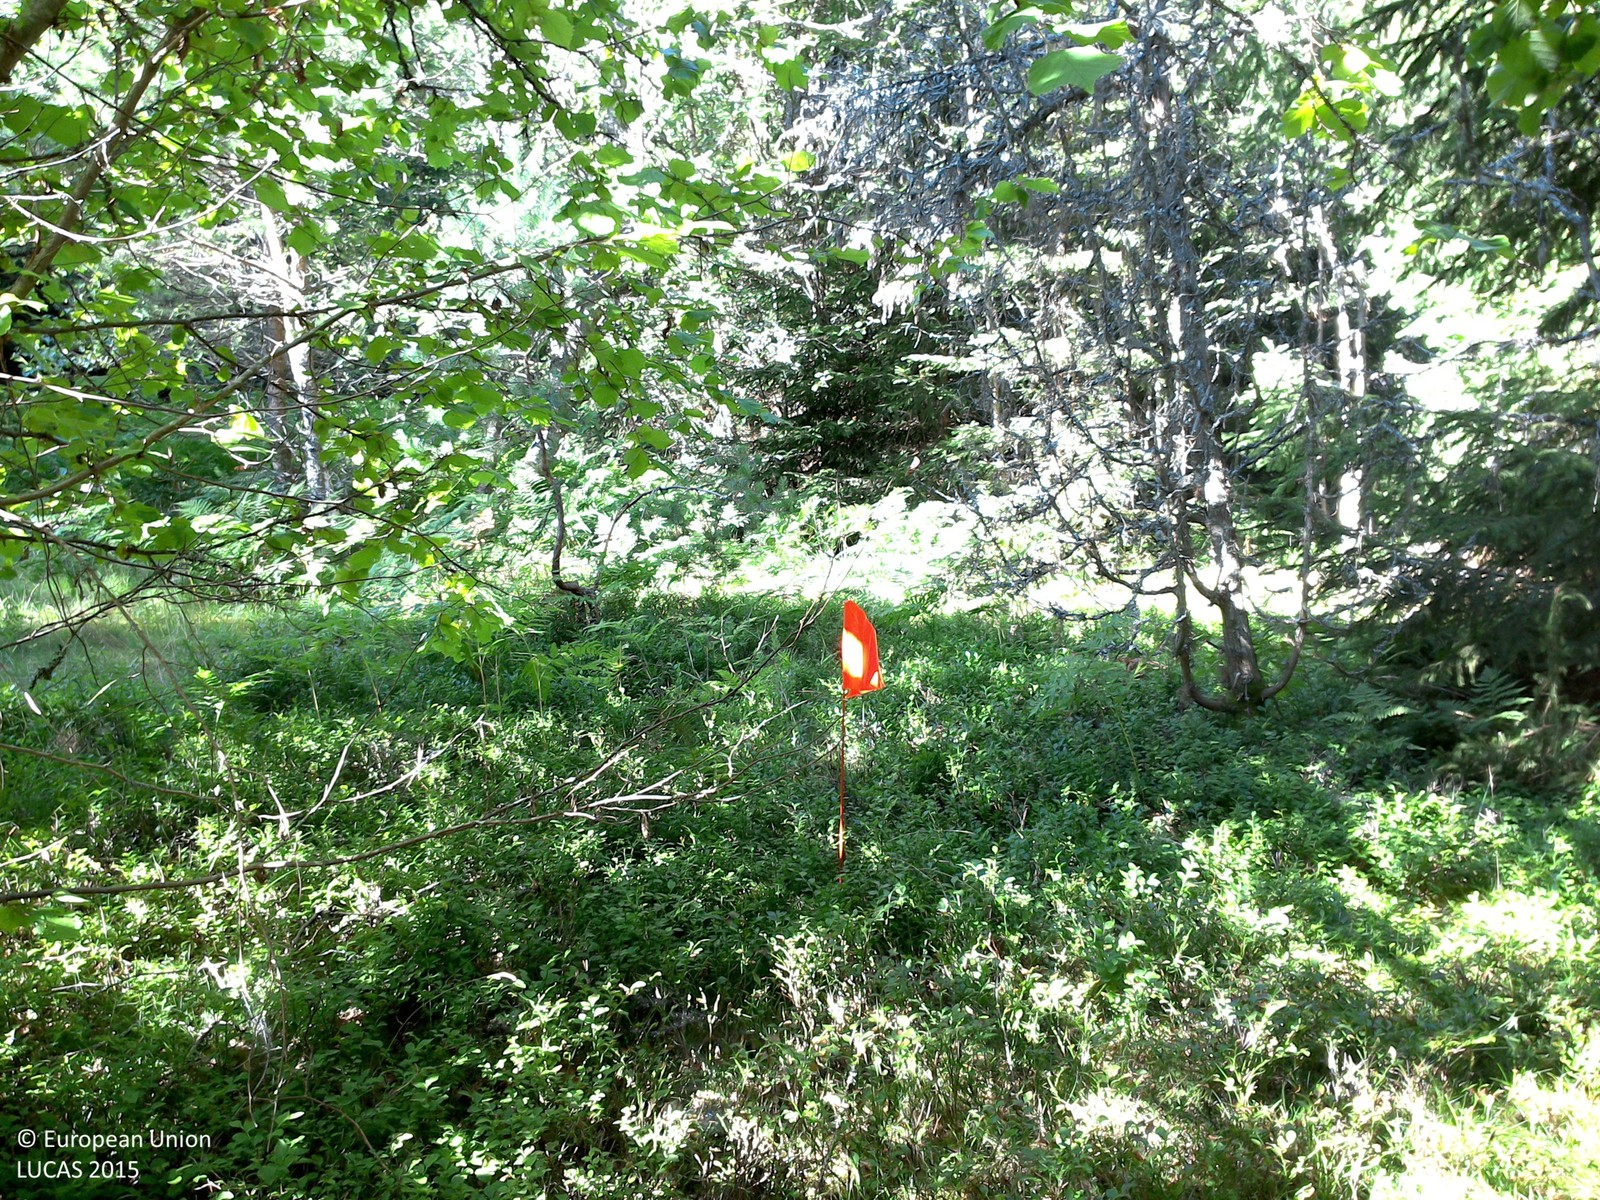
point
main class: Woodland
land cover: Spruce dominated mixed woodland
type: boreal forest
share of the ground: 50 - 75 %
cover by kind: coniferous forest trees 50 %, herbaceous plants 30 %, broadleaved forest trees 20 %
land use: Forestry
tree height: > 5 m
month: August
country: SE
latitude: 58.0906
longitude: 14.9985
